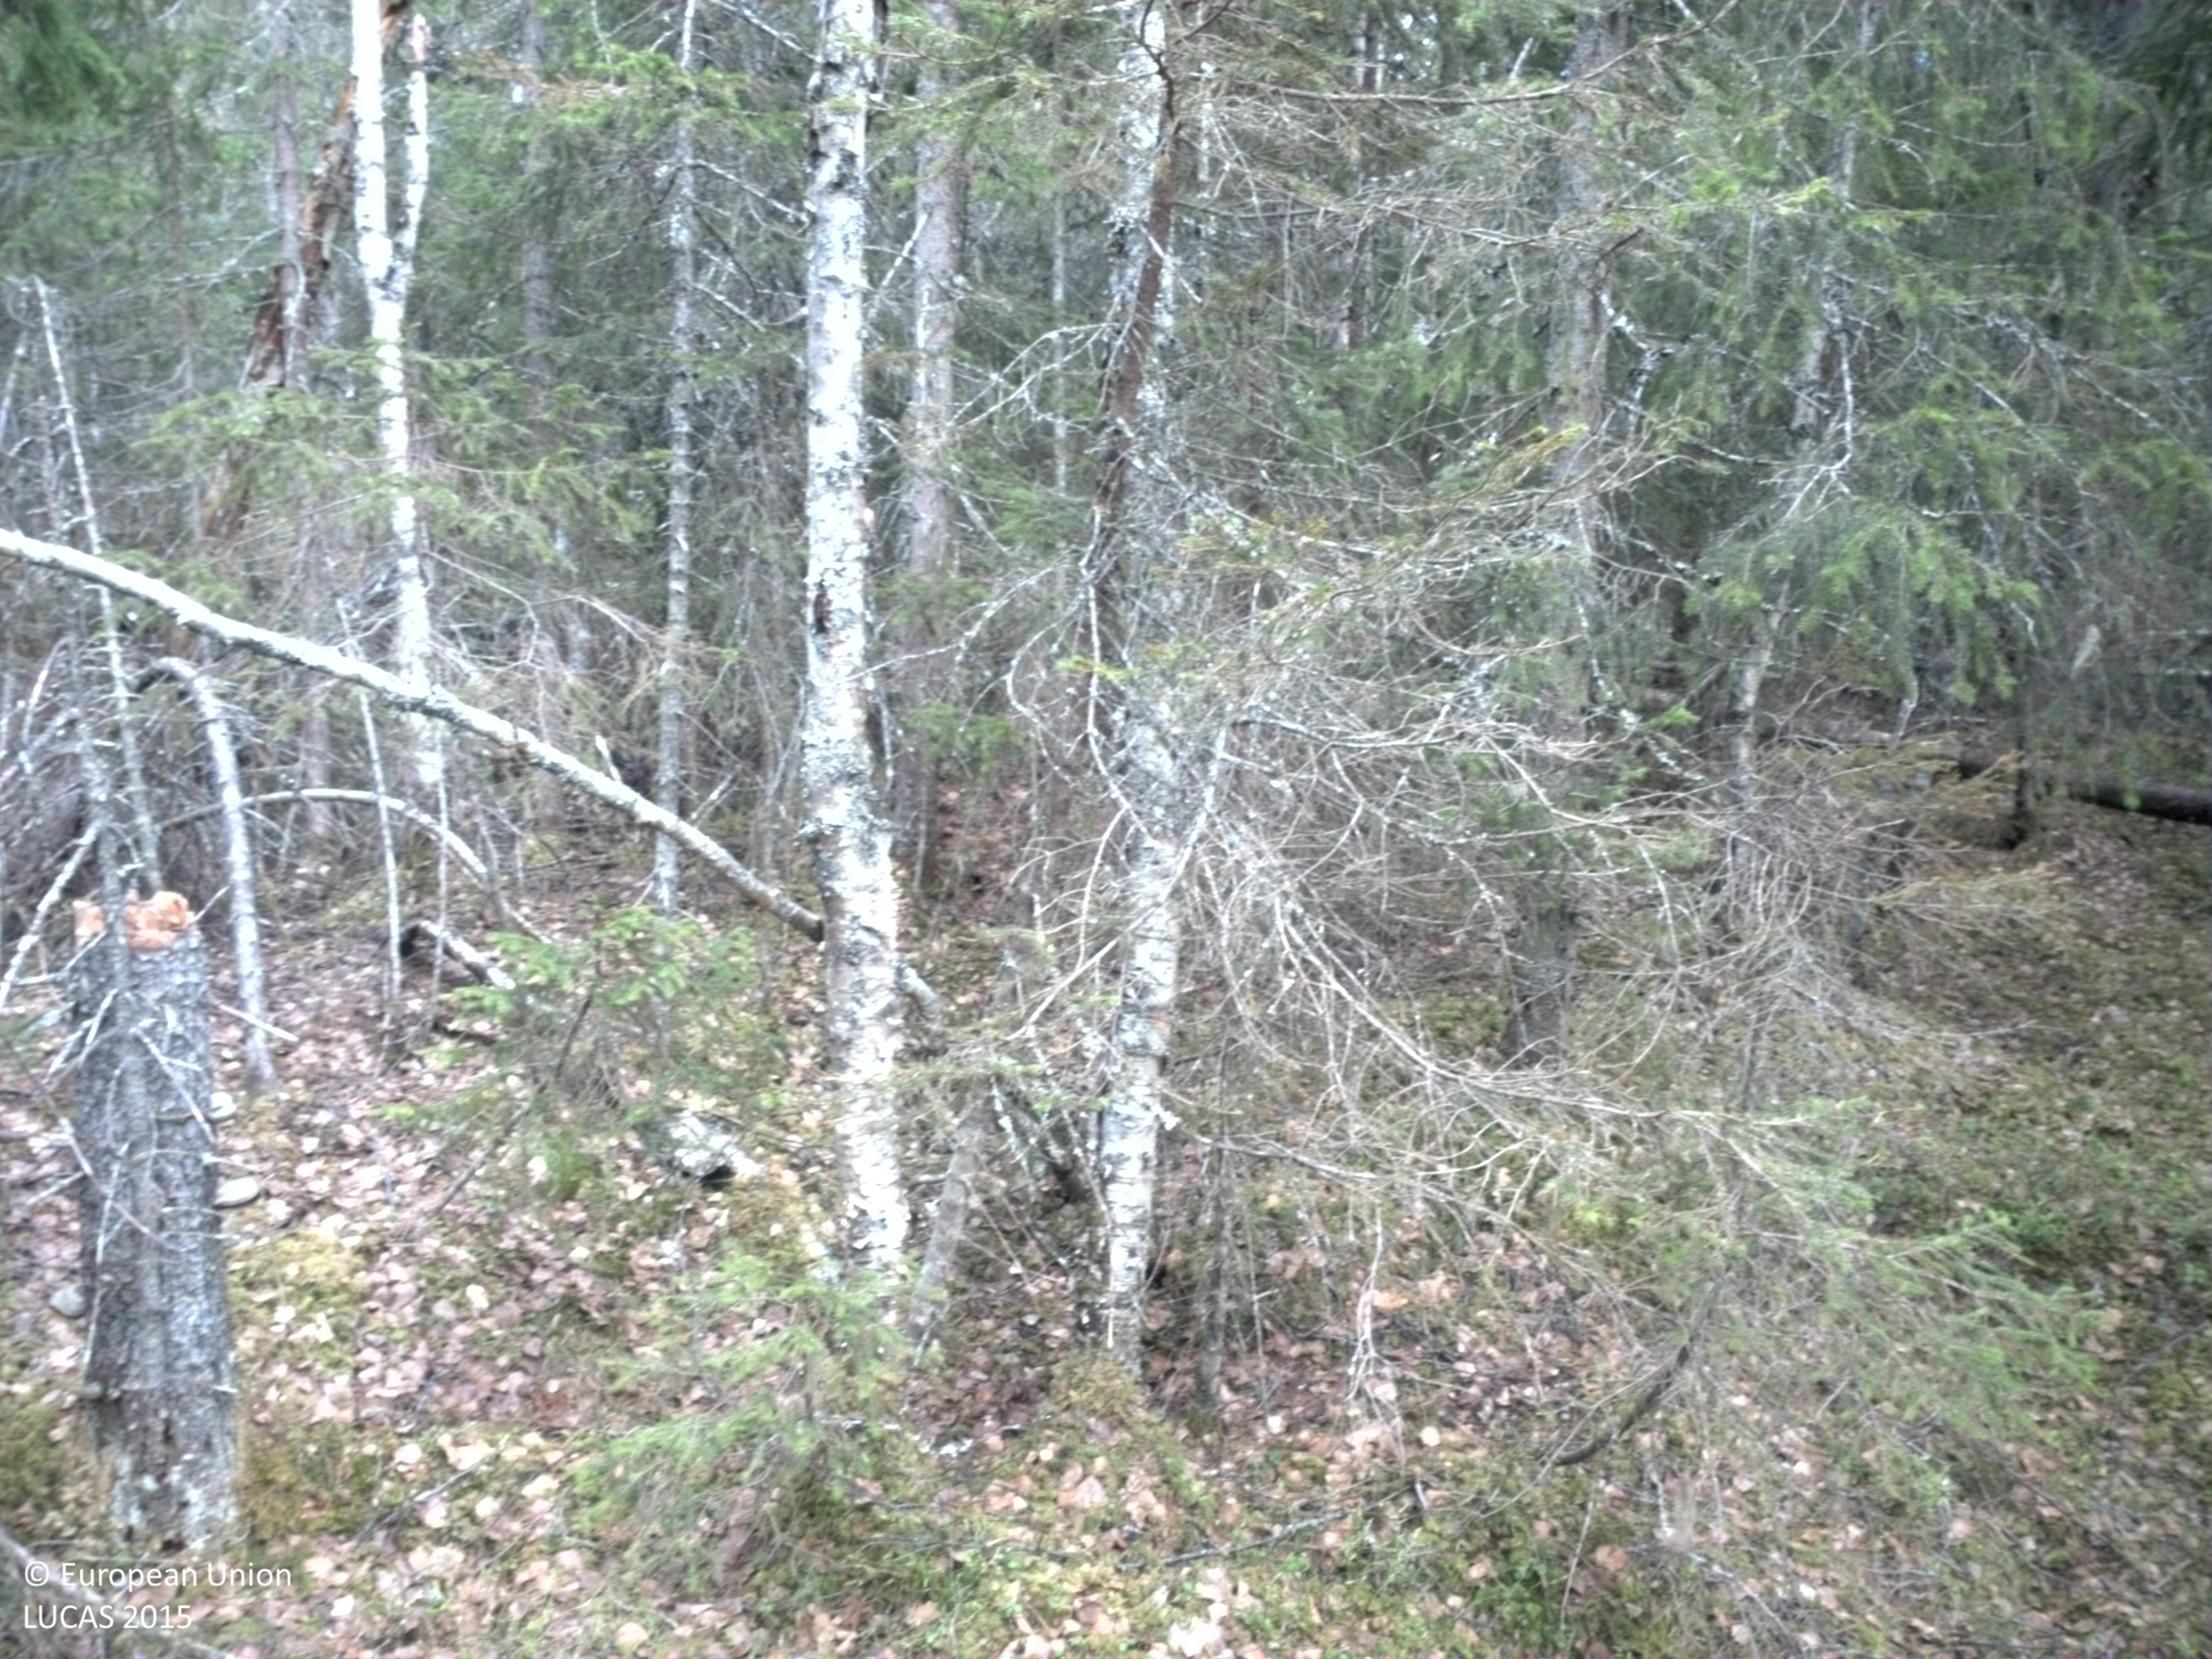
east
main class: Woodland
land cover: Spruce dominated mixed woodland
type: boreal forest
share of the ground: > 75 %
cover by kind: coniferous forest trees 60 %, broadleaved forest trees 20 %, shrubs 10 %, lichens and mosses 10 %
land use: Forestry
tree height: > 5 m
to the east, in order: Spruce dominated mixed woodland; Ditches and canals; Spruce dominated mixed woodland; Tracks; Ditches and canals; Spruce dominated mixed woodland
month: June
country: SE
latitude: 63.5179
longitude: 13.9396
